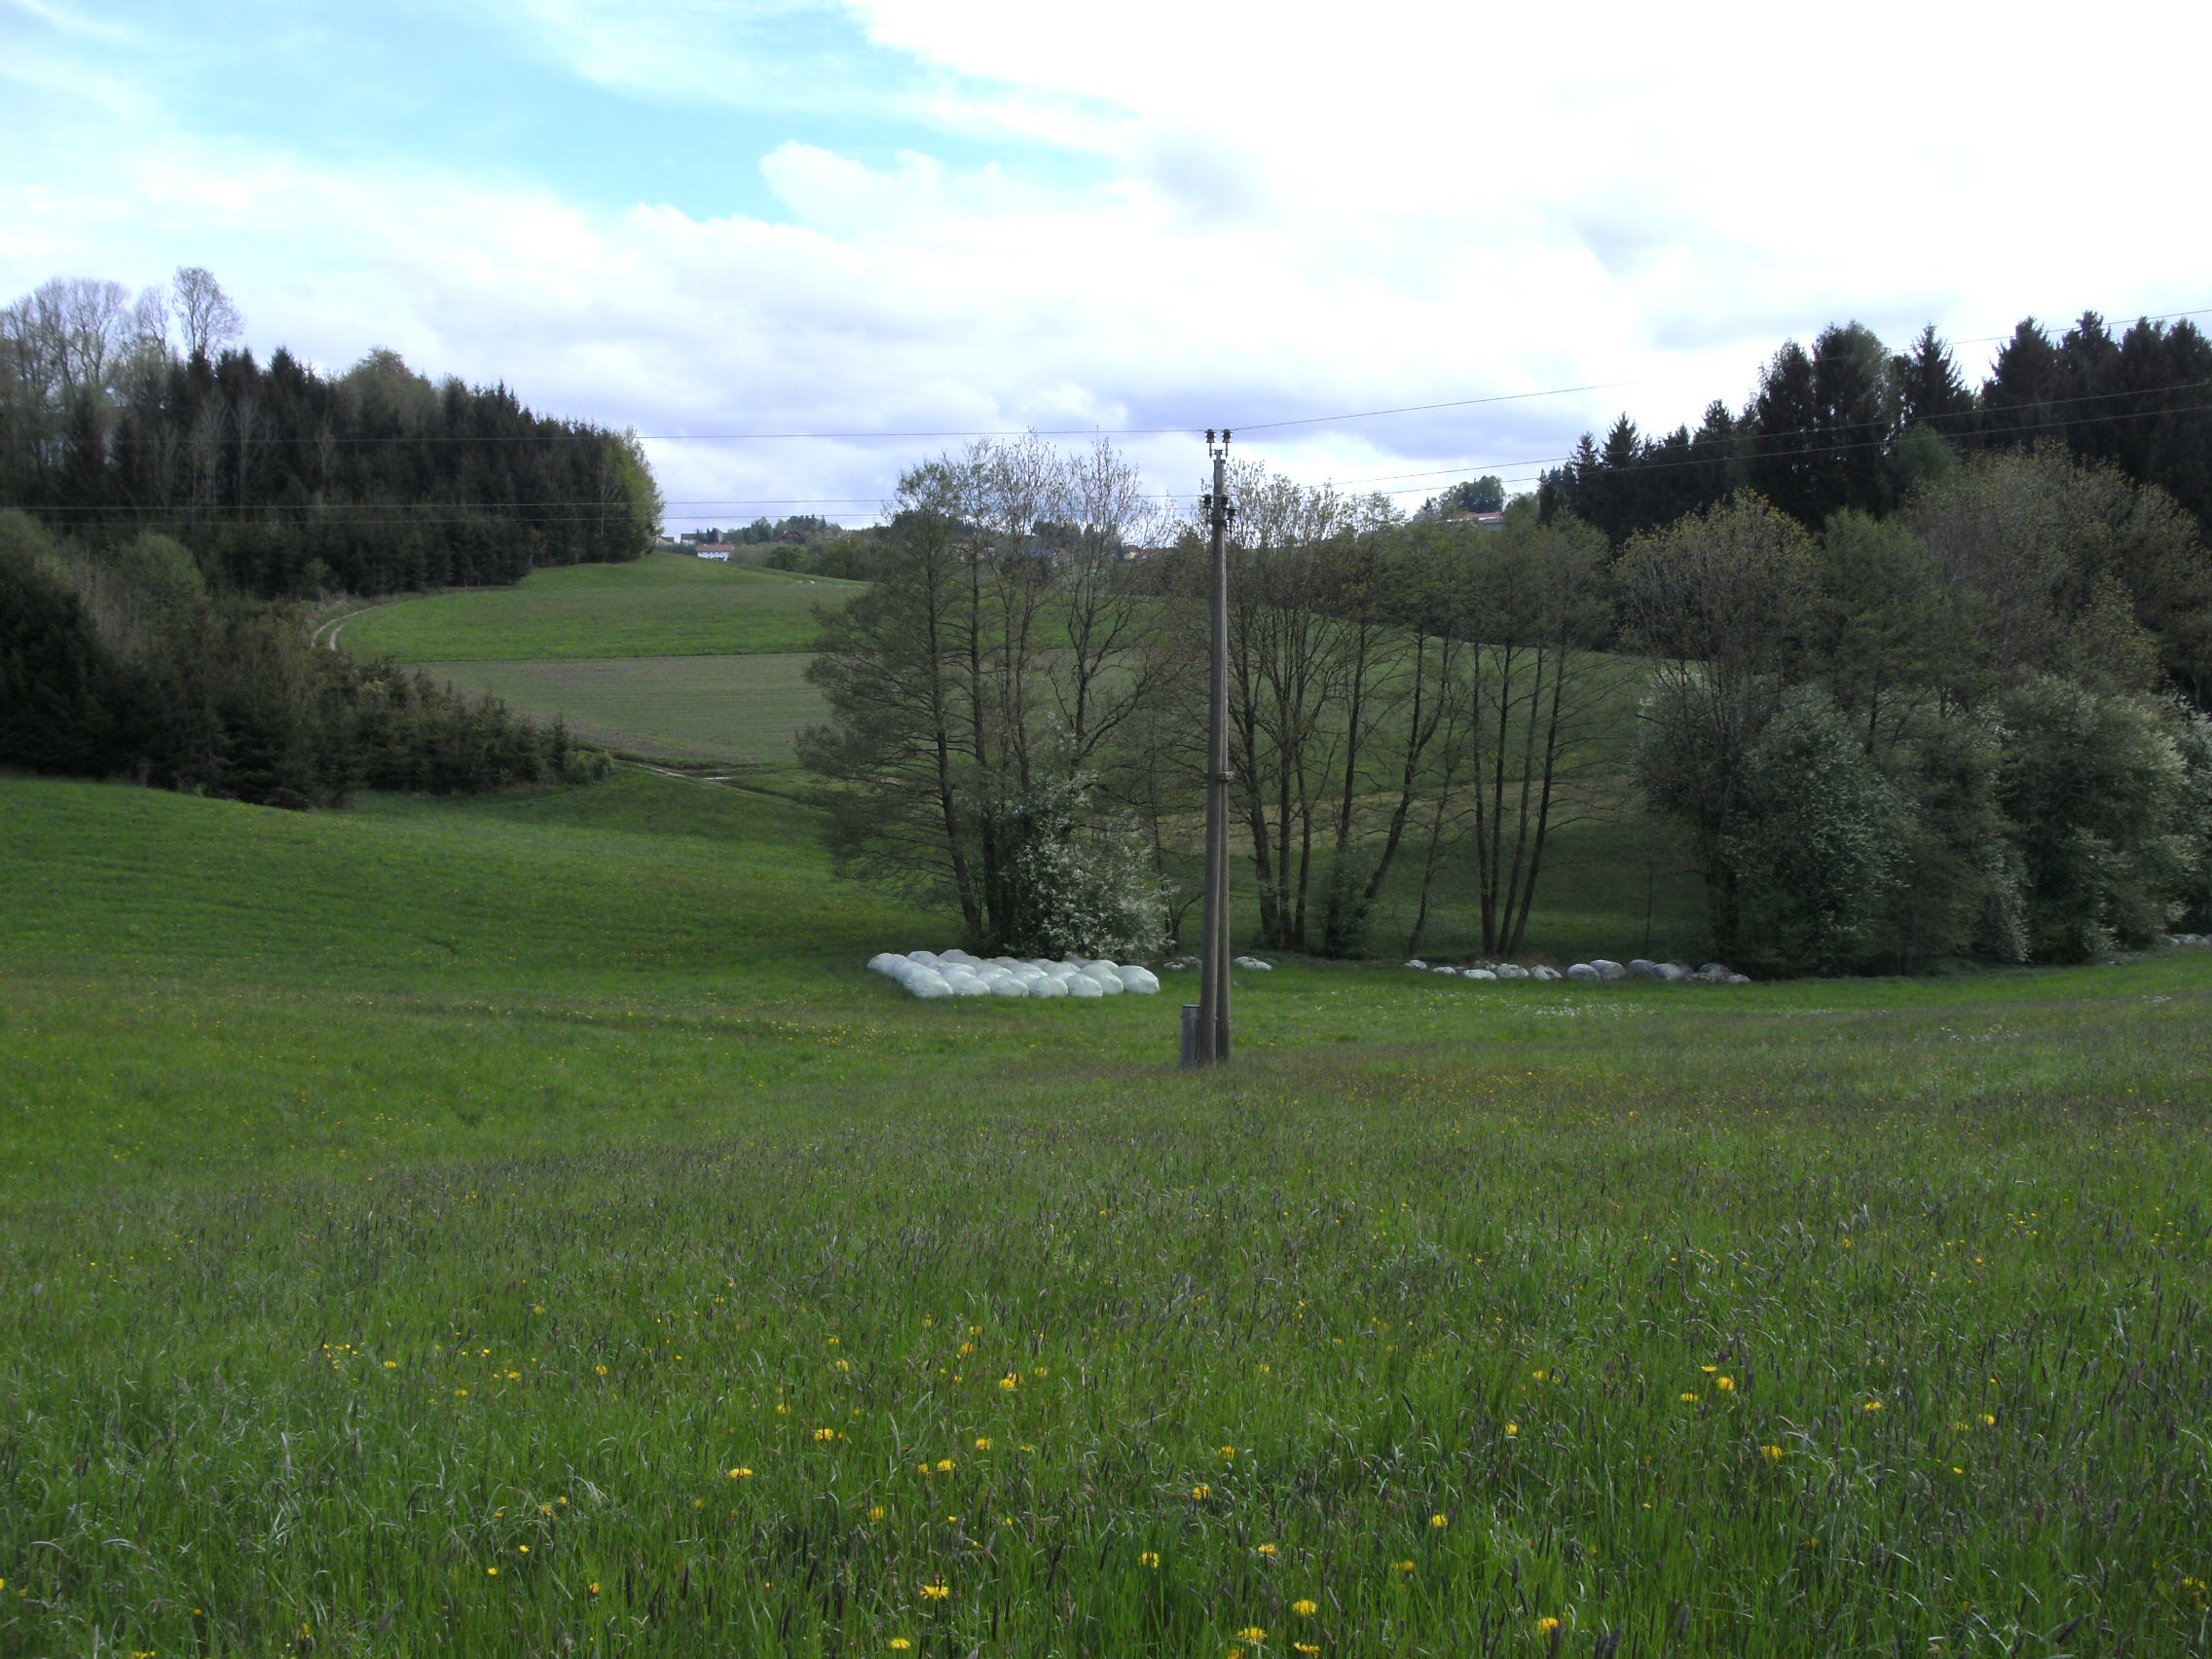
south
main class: Grassland
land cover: Grassland without tree/shrub cover
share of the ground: > 75 %
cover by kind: herbaceous plants 100 %
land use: Agriculture (excluding fallow land and kitchen gardens)
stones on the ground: < 10 %
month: May
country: AT
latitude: 48.1360
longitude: 13.3720
